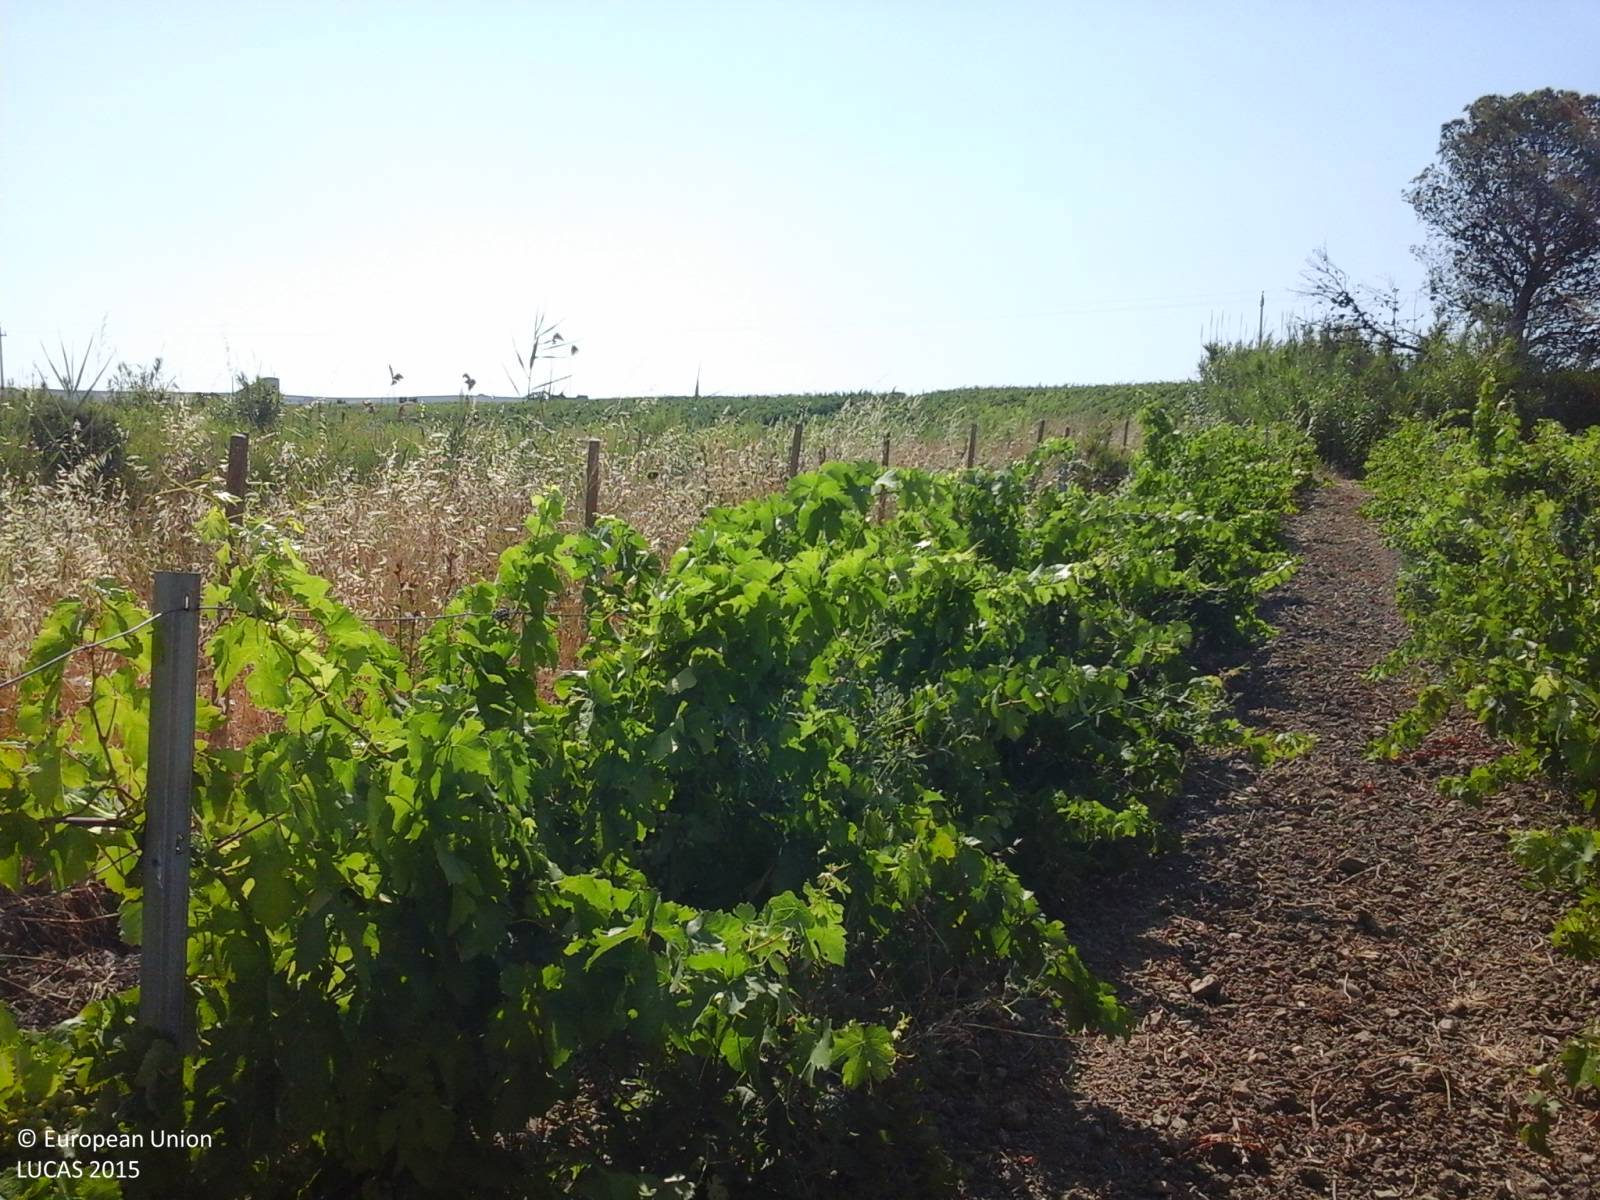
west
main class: Cropland
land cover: Vineyards
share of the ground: 50 - 75 %
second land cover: Other bare soil
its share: > 75 %
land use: Agriculture (excluding fallow land and kitchen gardens)
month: July
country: IT
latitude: 37.7833
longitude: 12.6485
